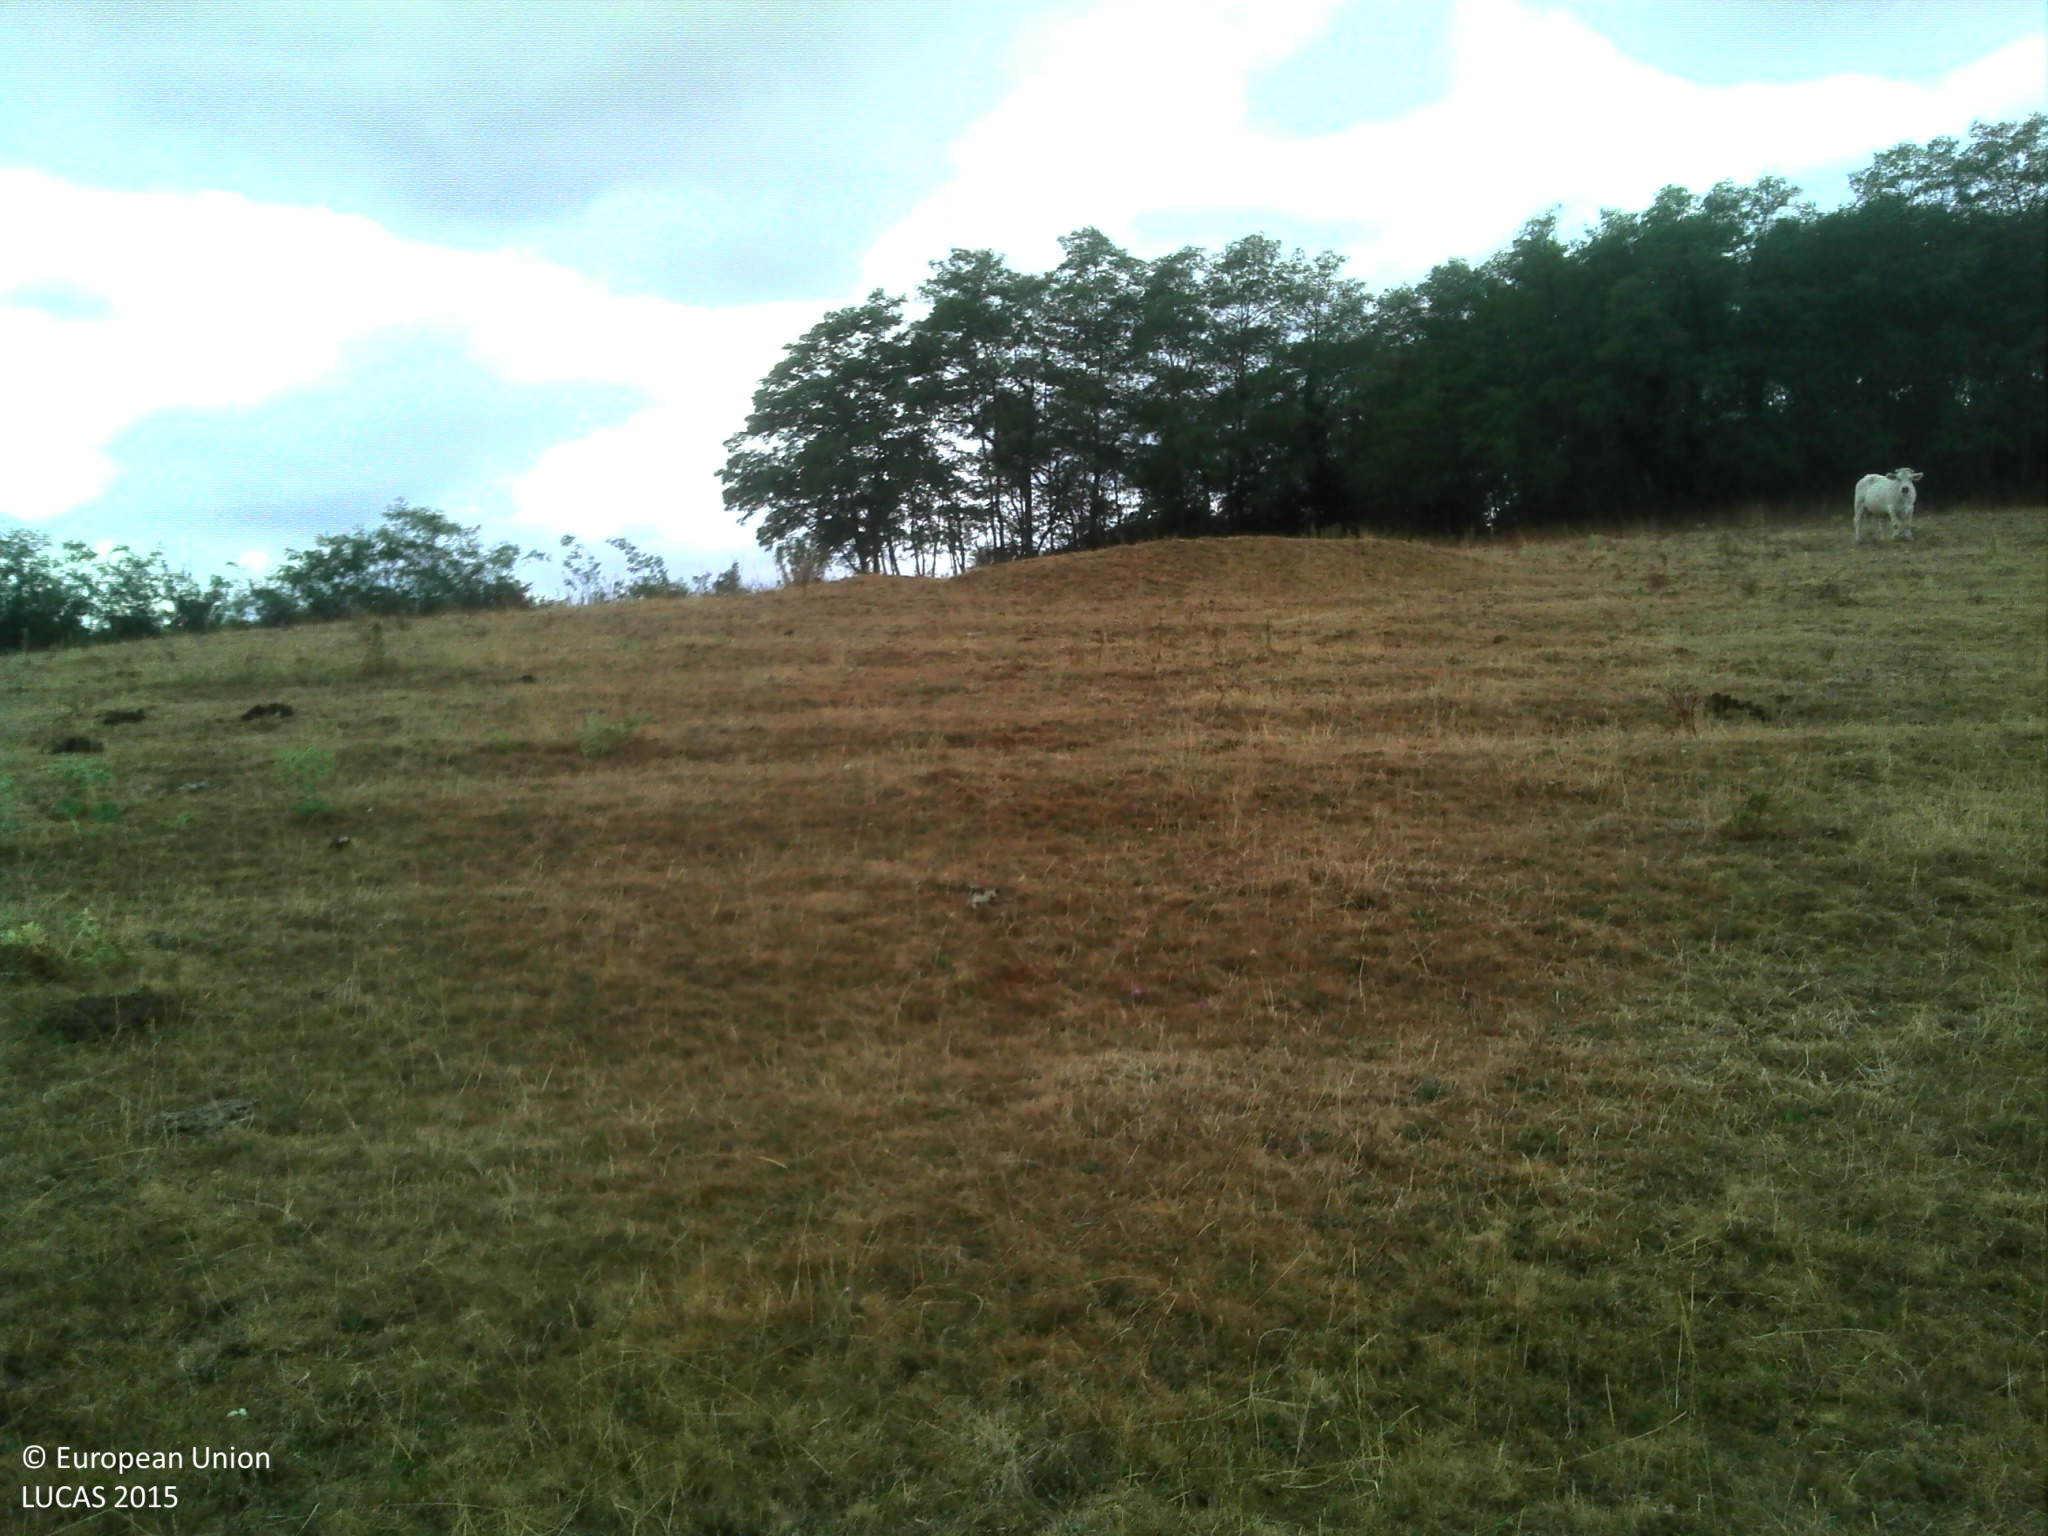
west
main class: Grassland
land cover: Grassland without tree/shrub cover
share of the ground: > 75 %
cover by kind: herbaceous plants 100 %
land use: Agriculture (excluding fallow land and kitchen gardens)
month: August
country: FR
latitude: 46.6084
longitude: 4.5306
